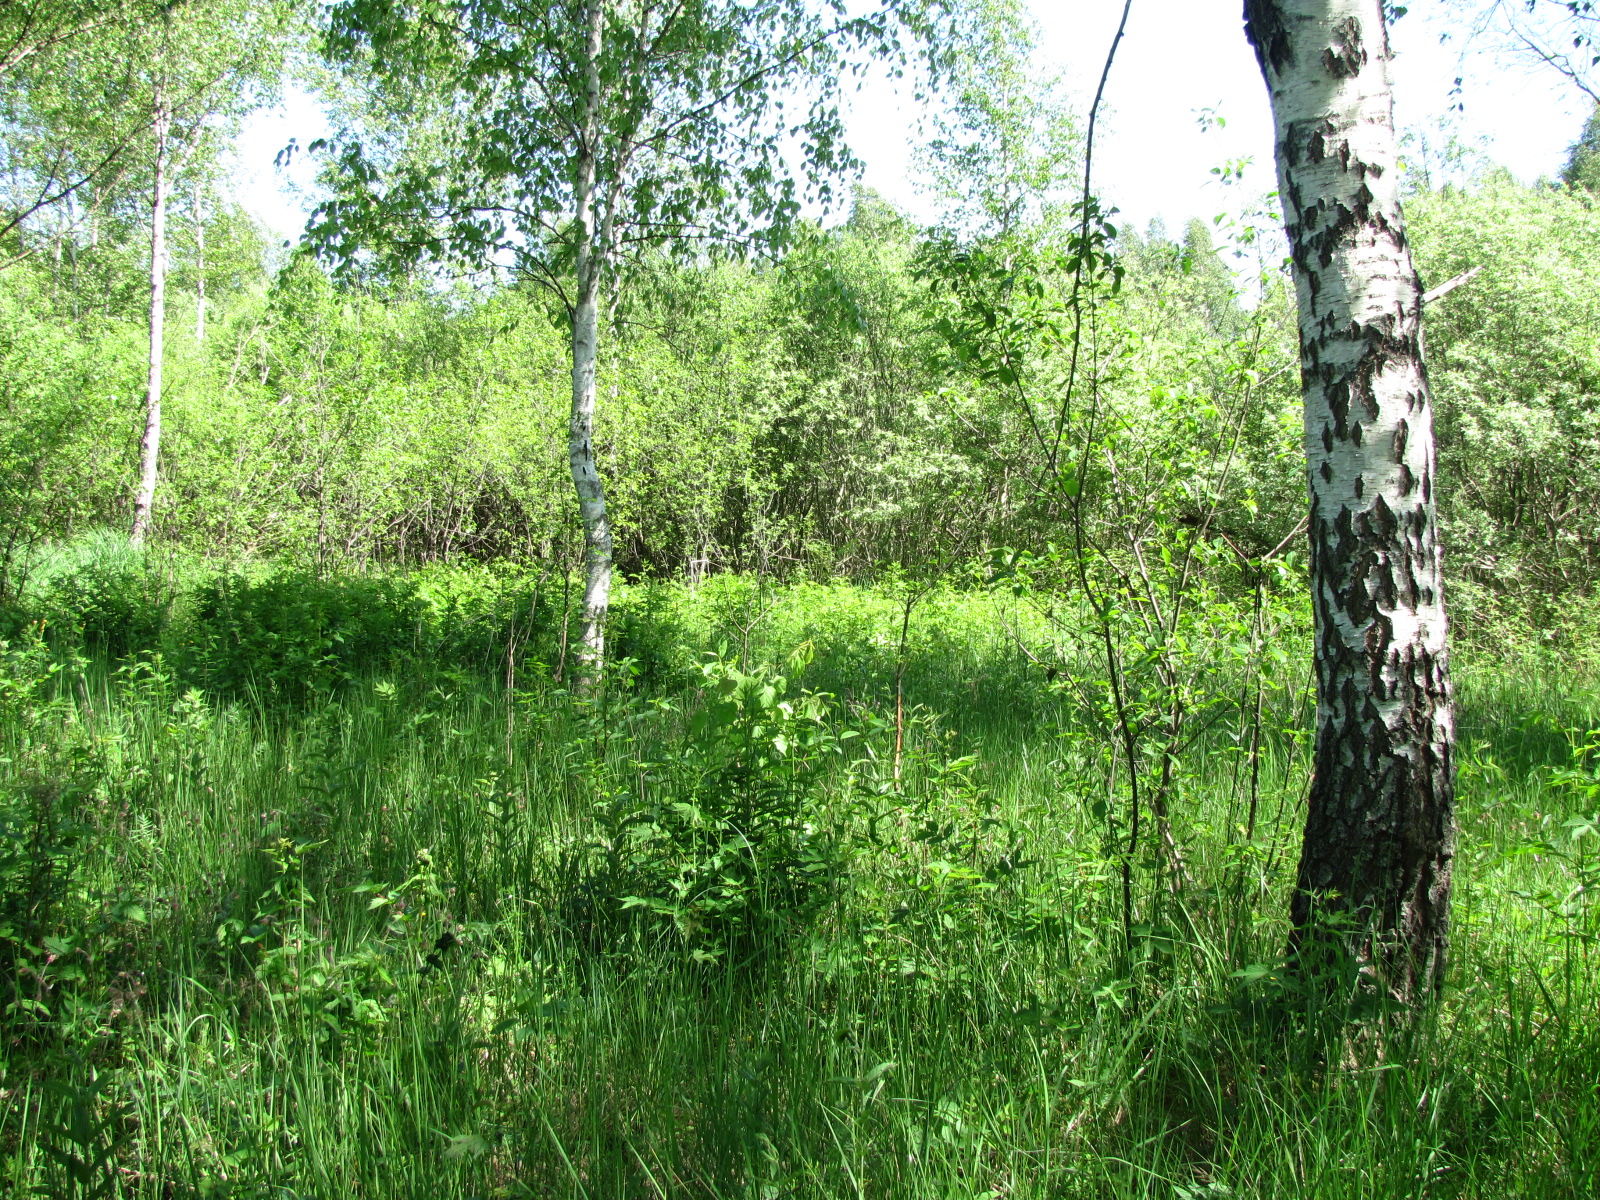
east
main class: Woodland
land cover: Broadleaved woodland
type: non-riverine alder, birch or aspen forest
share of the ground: > 75 %
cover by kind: broadleaved forest trees 80 %, herbaceous plants 20 %
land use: Semi-natural and natural areas not in use
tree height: > 5 m
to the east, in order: Broadleaved woodland; Grassland with sparse tree/shrub cover; Broadleaved woodland; Grassland without tree/shrub cover; Broadleaved woodland; Shrubland with sparse tree cover; Grassland with sparse tree/shrub cover; Broadleaved woodland; Grassland without tree/shrub cover; Shrubland without tree cover
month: June
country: LV
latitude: 56.5141
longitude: 24.3117
